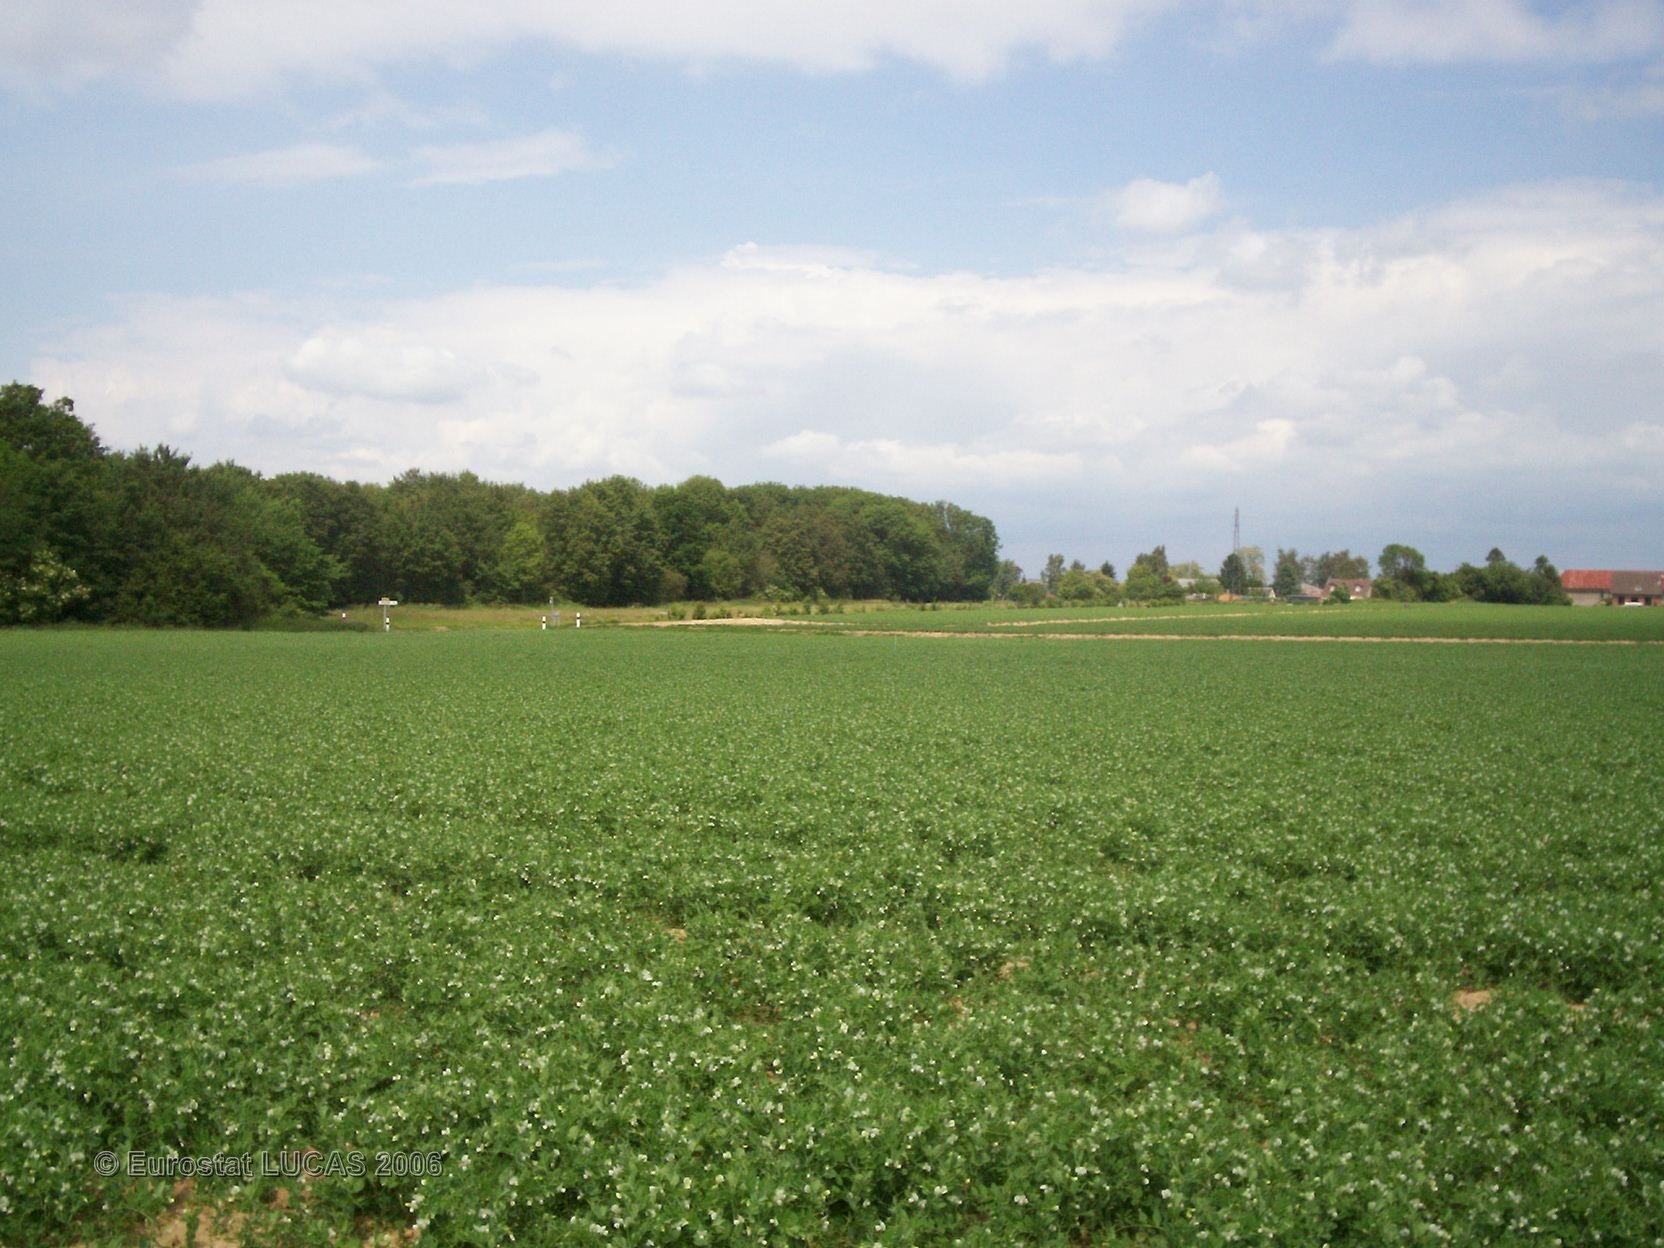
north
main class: Cropland
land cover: Dry pulses
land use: Agriculture (excluding fallow land and kitchen gardens)
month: June
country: FR
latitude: 49.7105
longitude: 2.6247
